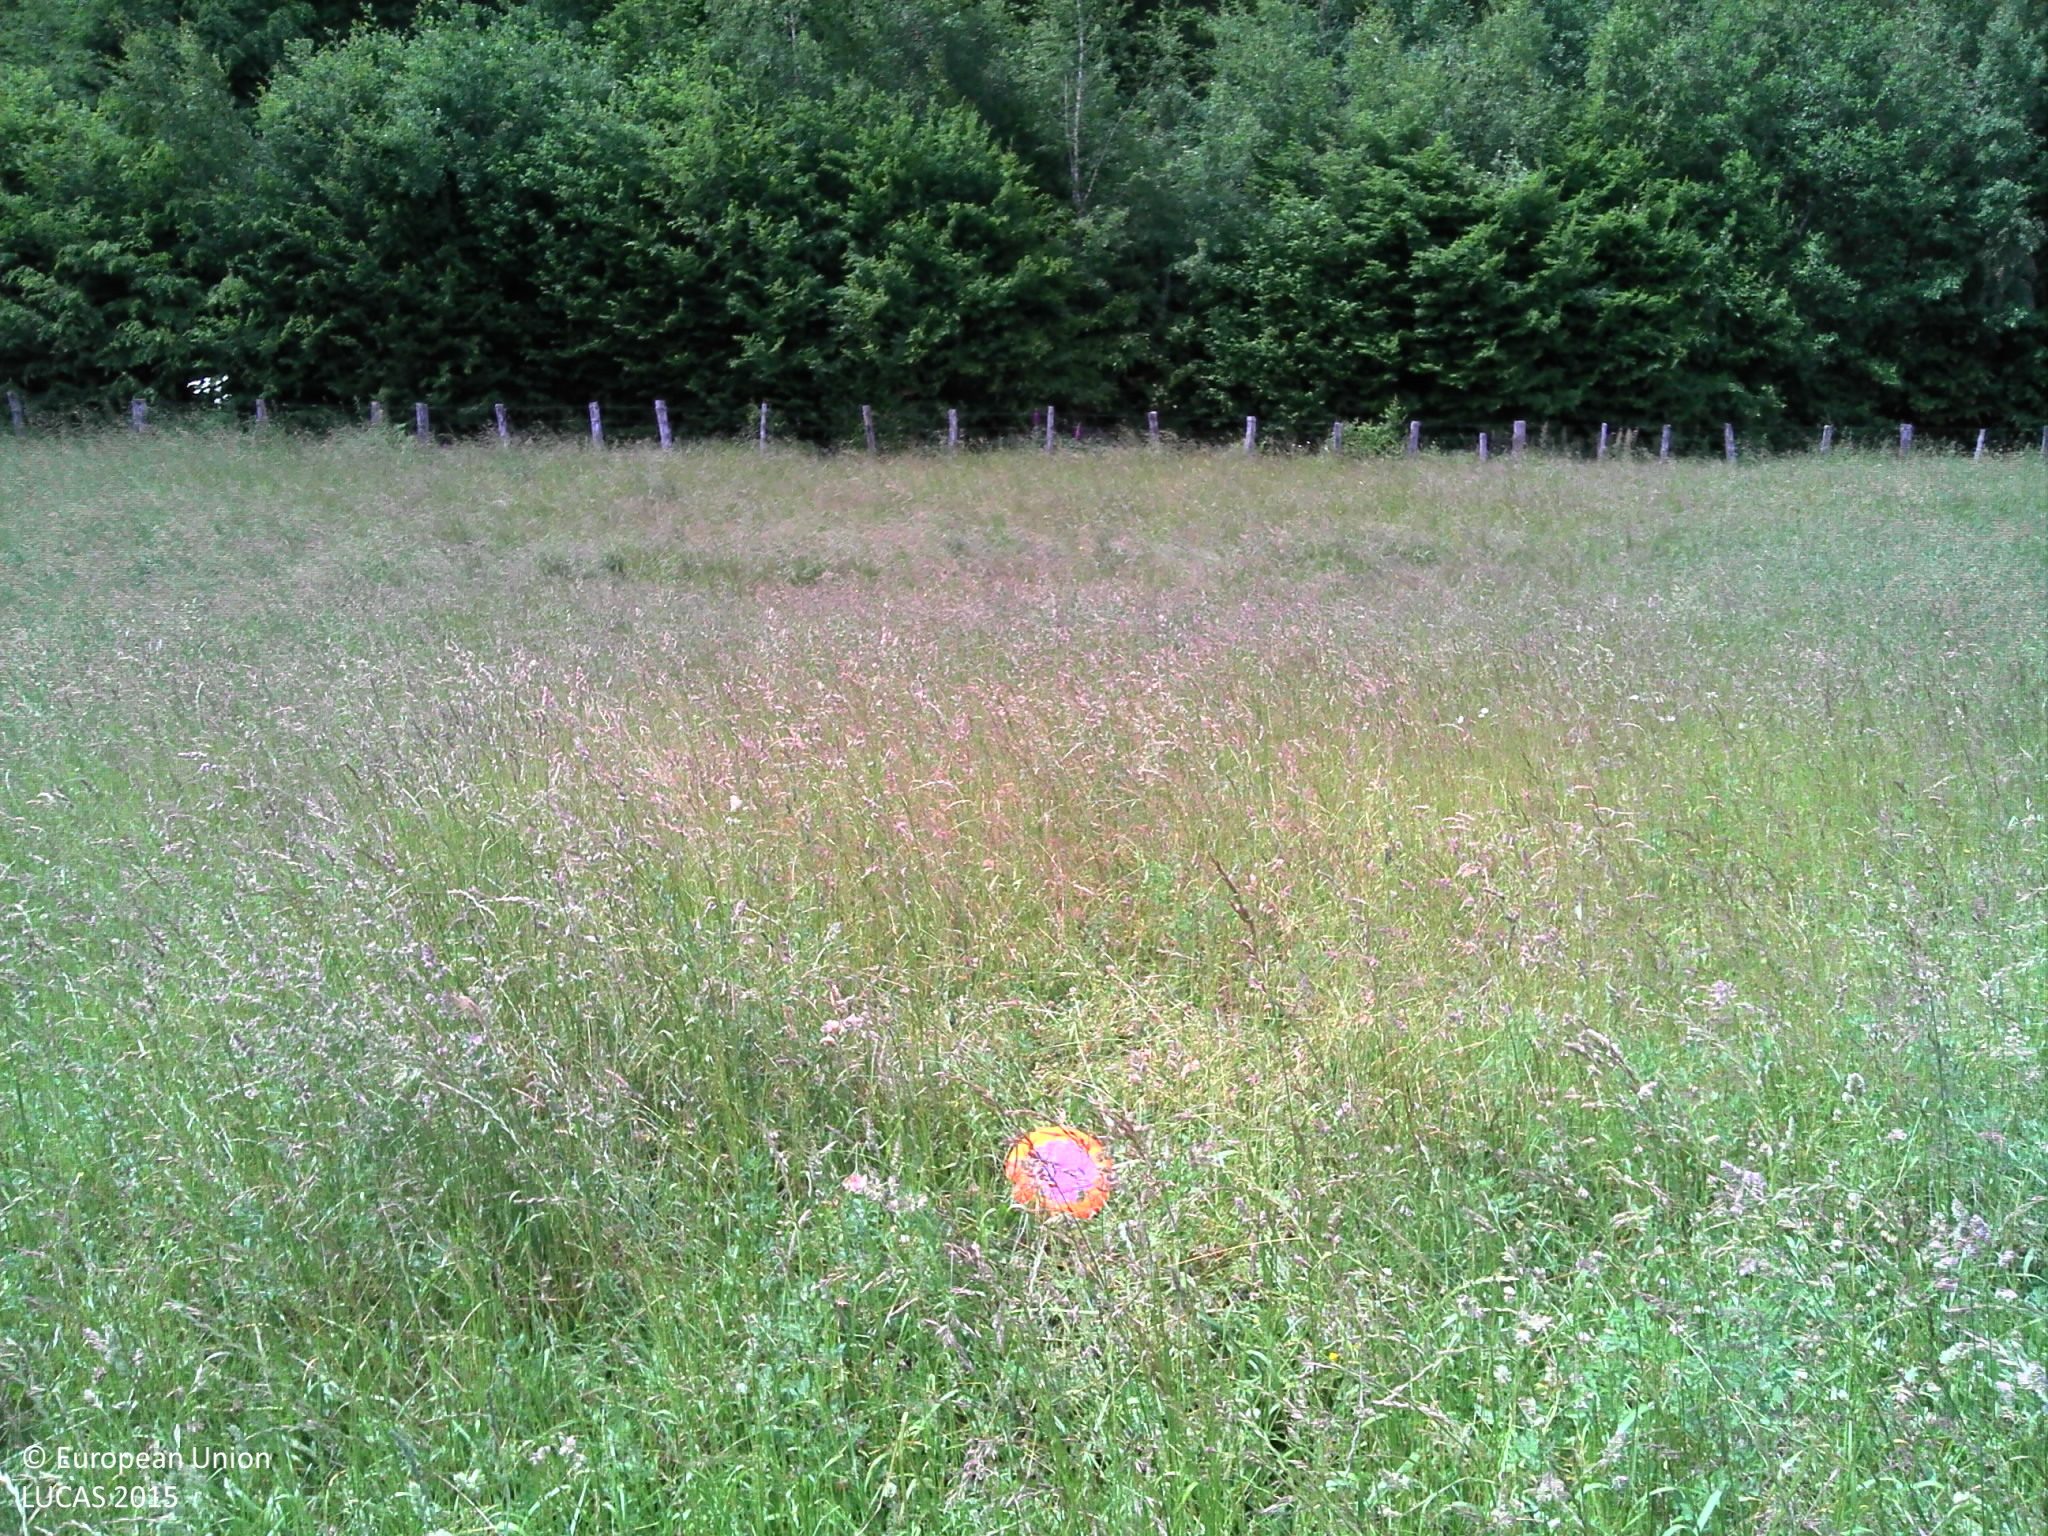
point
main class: Grassland
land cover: Grassland without tree/shrub cover
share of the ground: > 75 %
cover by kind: herbaceous plants 100 %
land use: Agriculture (excluding fallow land and kitchen gardens)
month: June
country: FR
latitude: 47.4401
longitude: 3.8847
